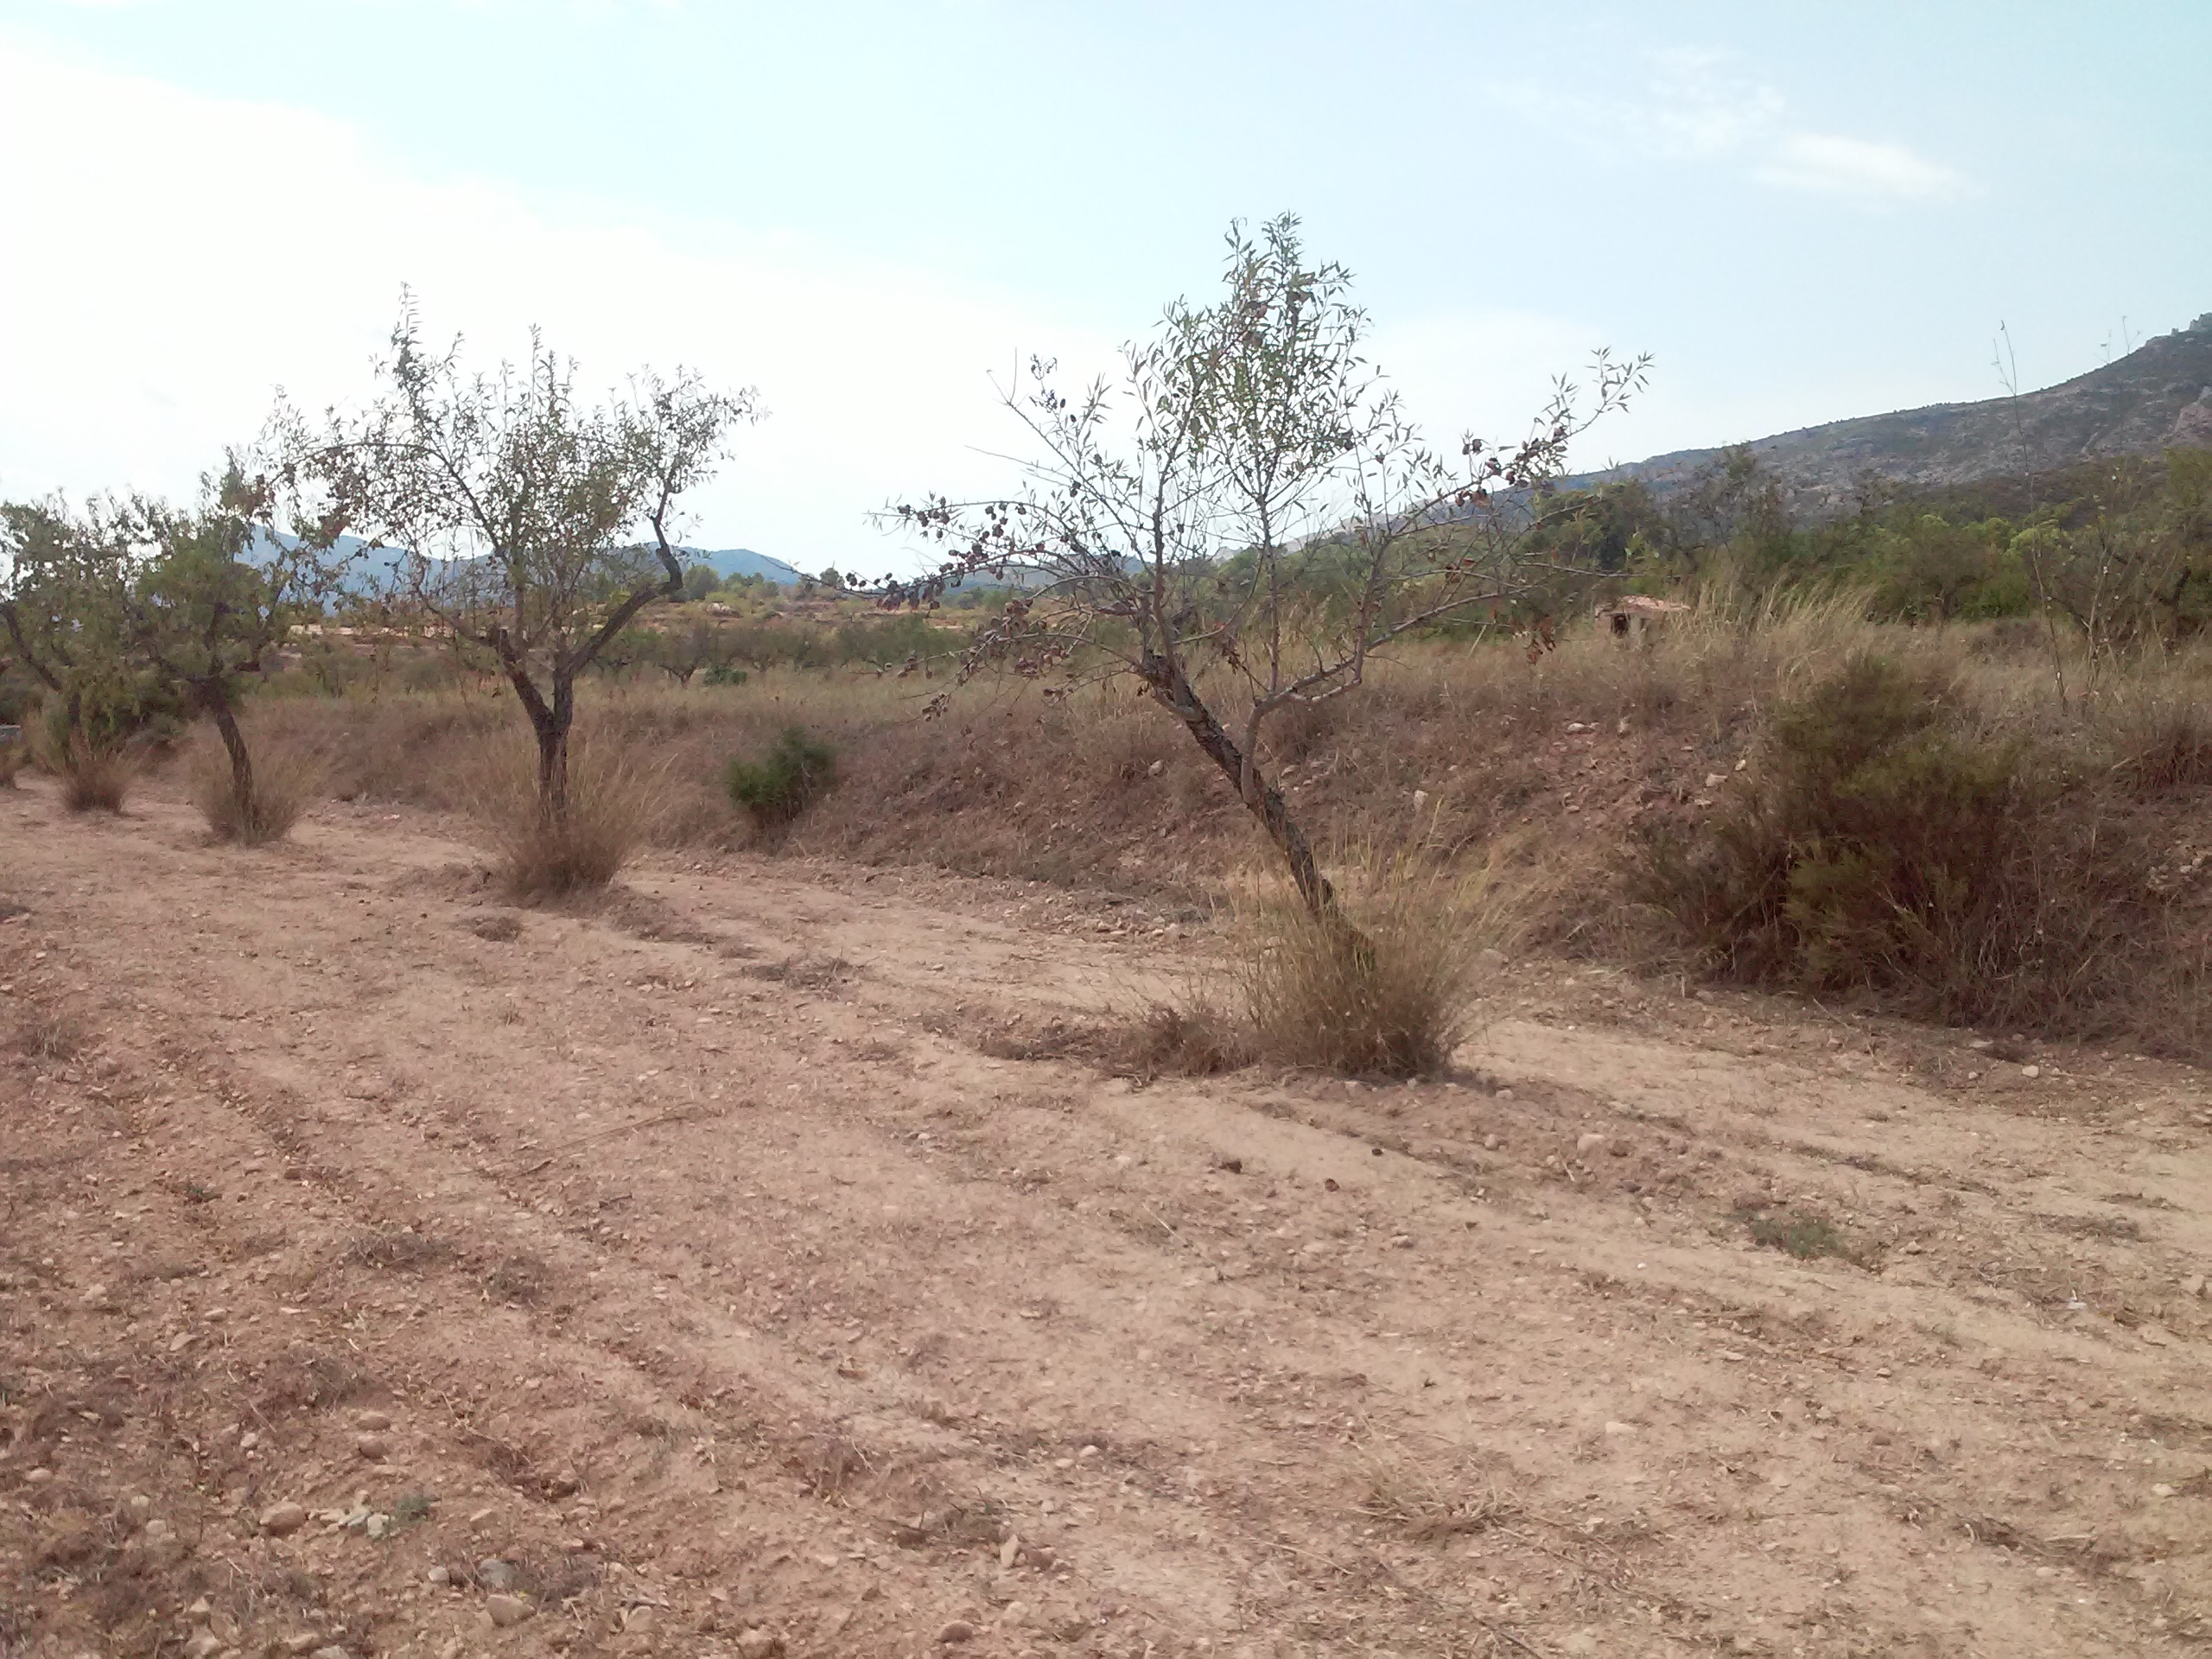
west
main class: Cropland
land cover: Nuts trees
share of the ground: 10 - 25 %
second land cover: Other bare soil
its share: > 75 %
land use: Agriculture (excluding fallow land and kitchen gardens)
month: August
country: ES
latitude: 41.0462
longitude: 0.5340
